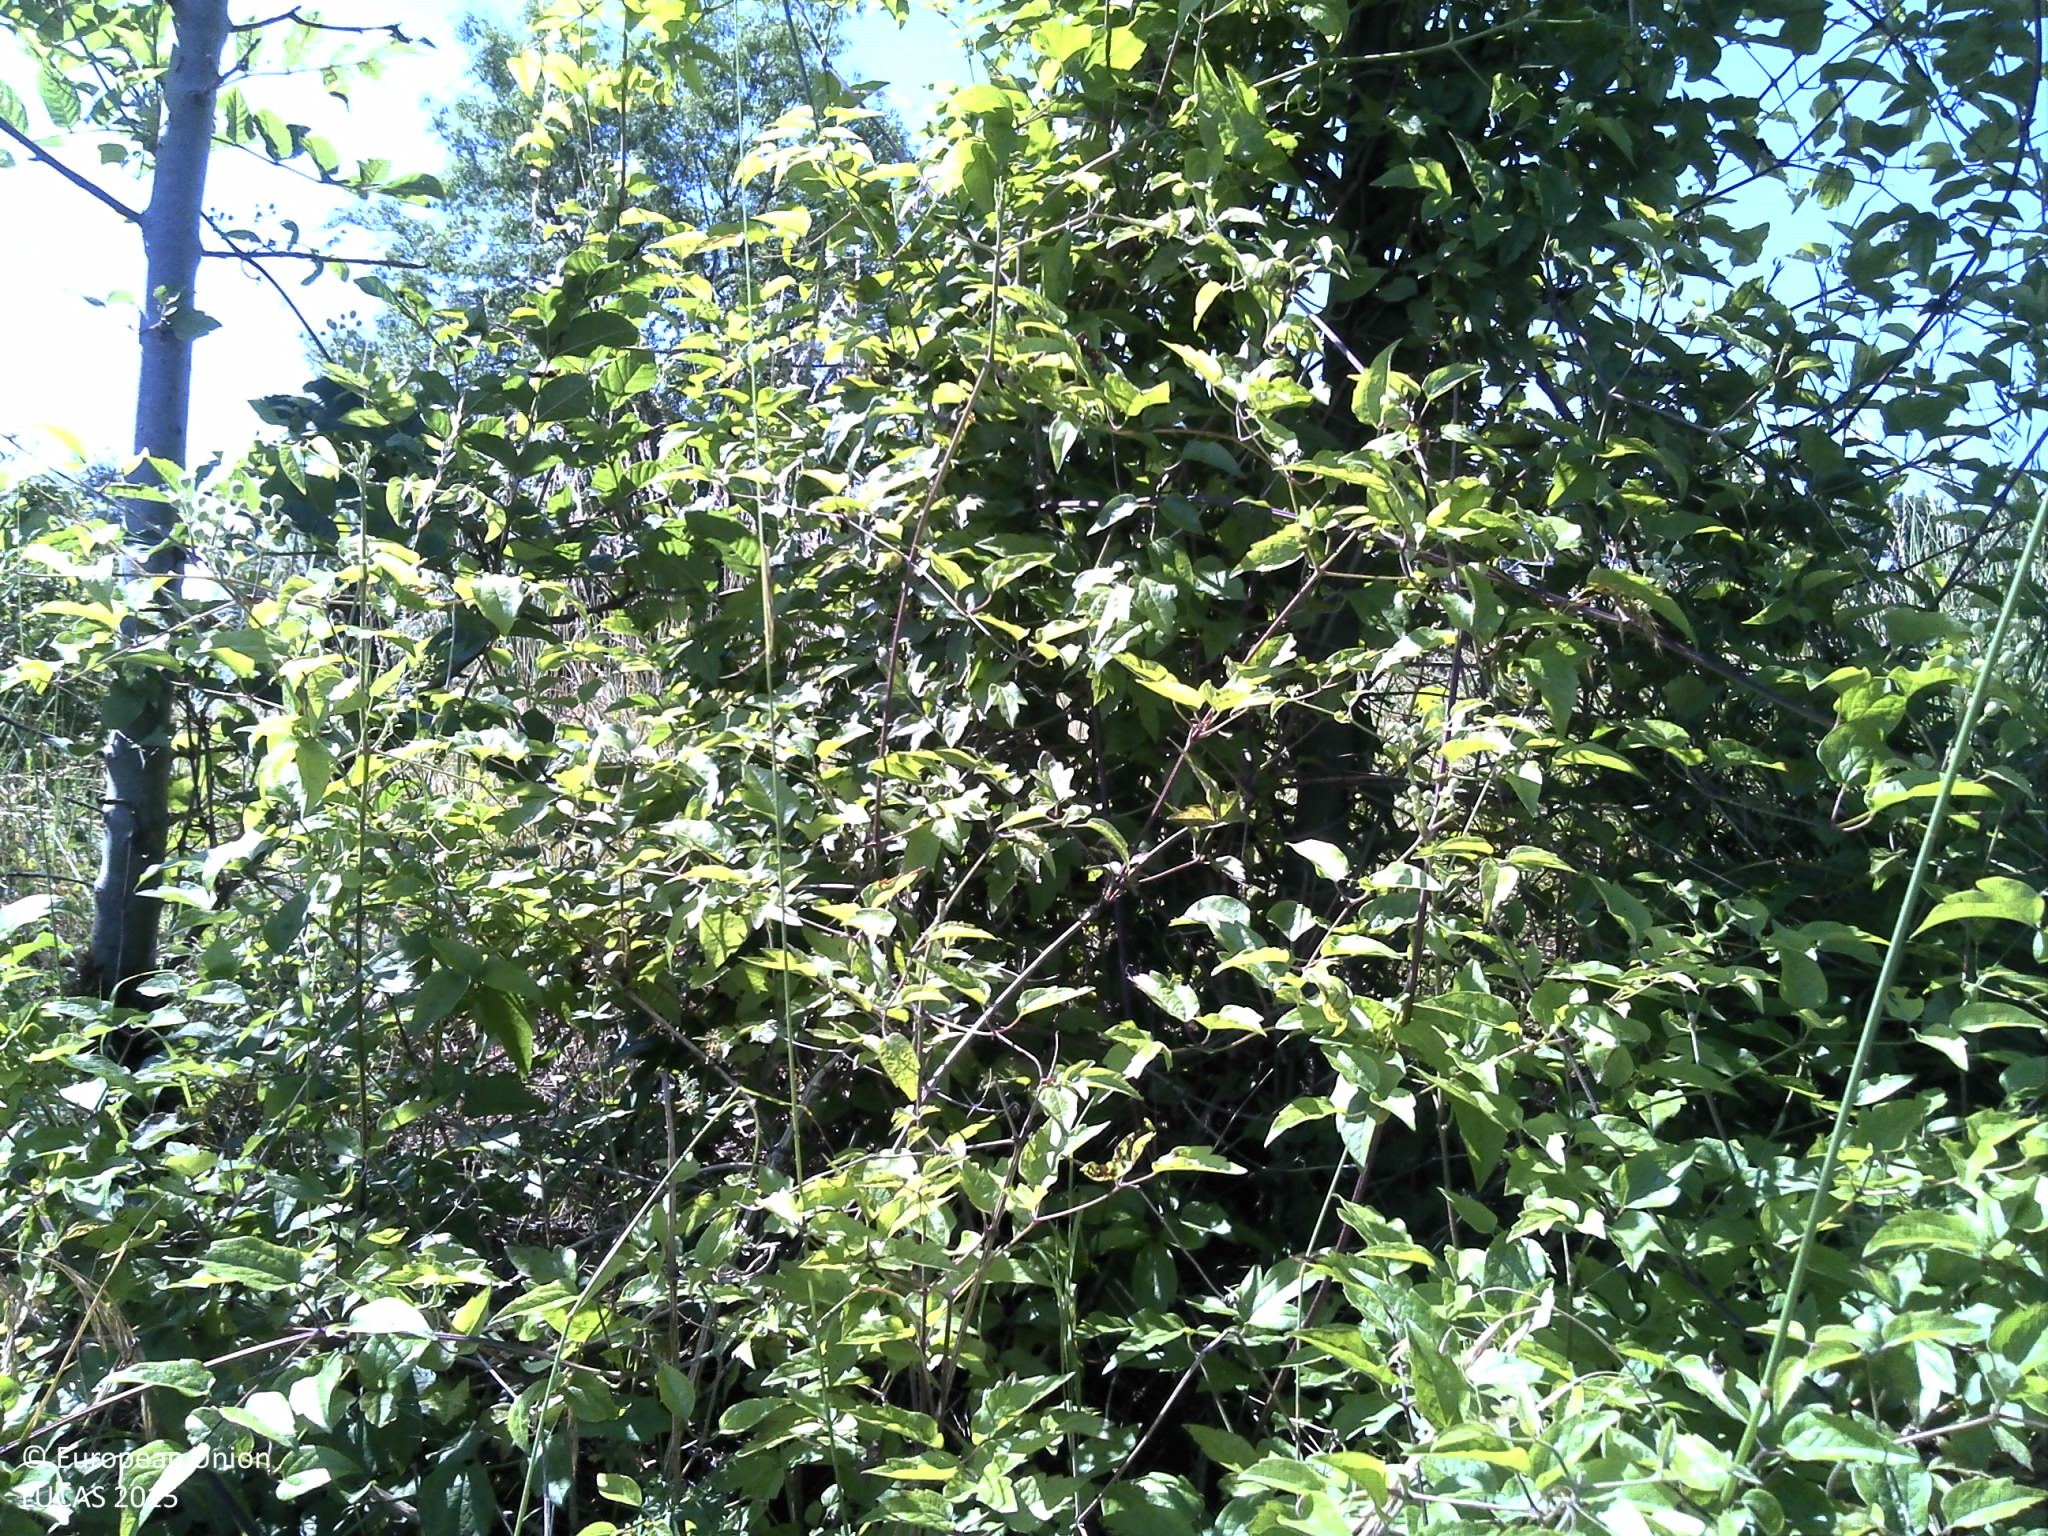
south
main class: Grassland
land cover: Grassland with sparse tree/shrub cover
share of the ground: > 75 %
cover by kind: herbaceous plants 95 %, broadleaved forest trees 5 %
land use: Semi-natural and natural areas not in use
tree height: < 5 m
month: June
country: FR
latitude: 50.1188
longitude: 4.7800
